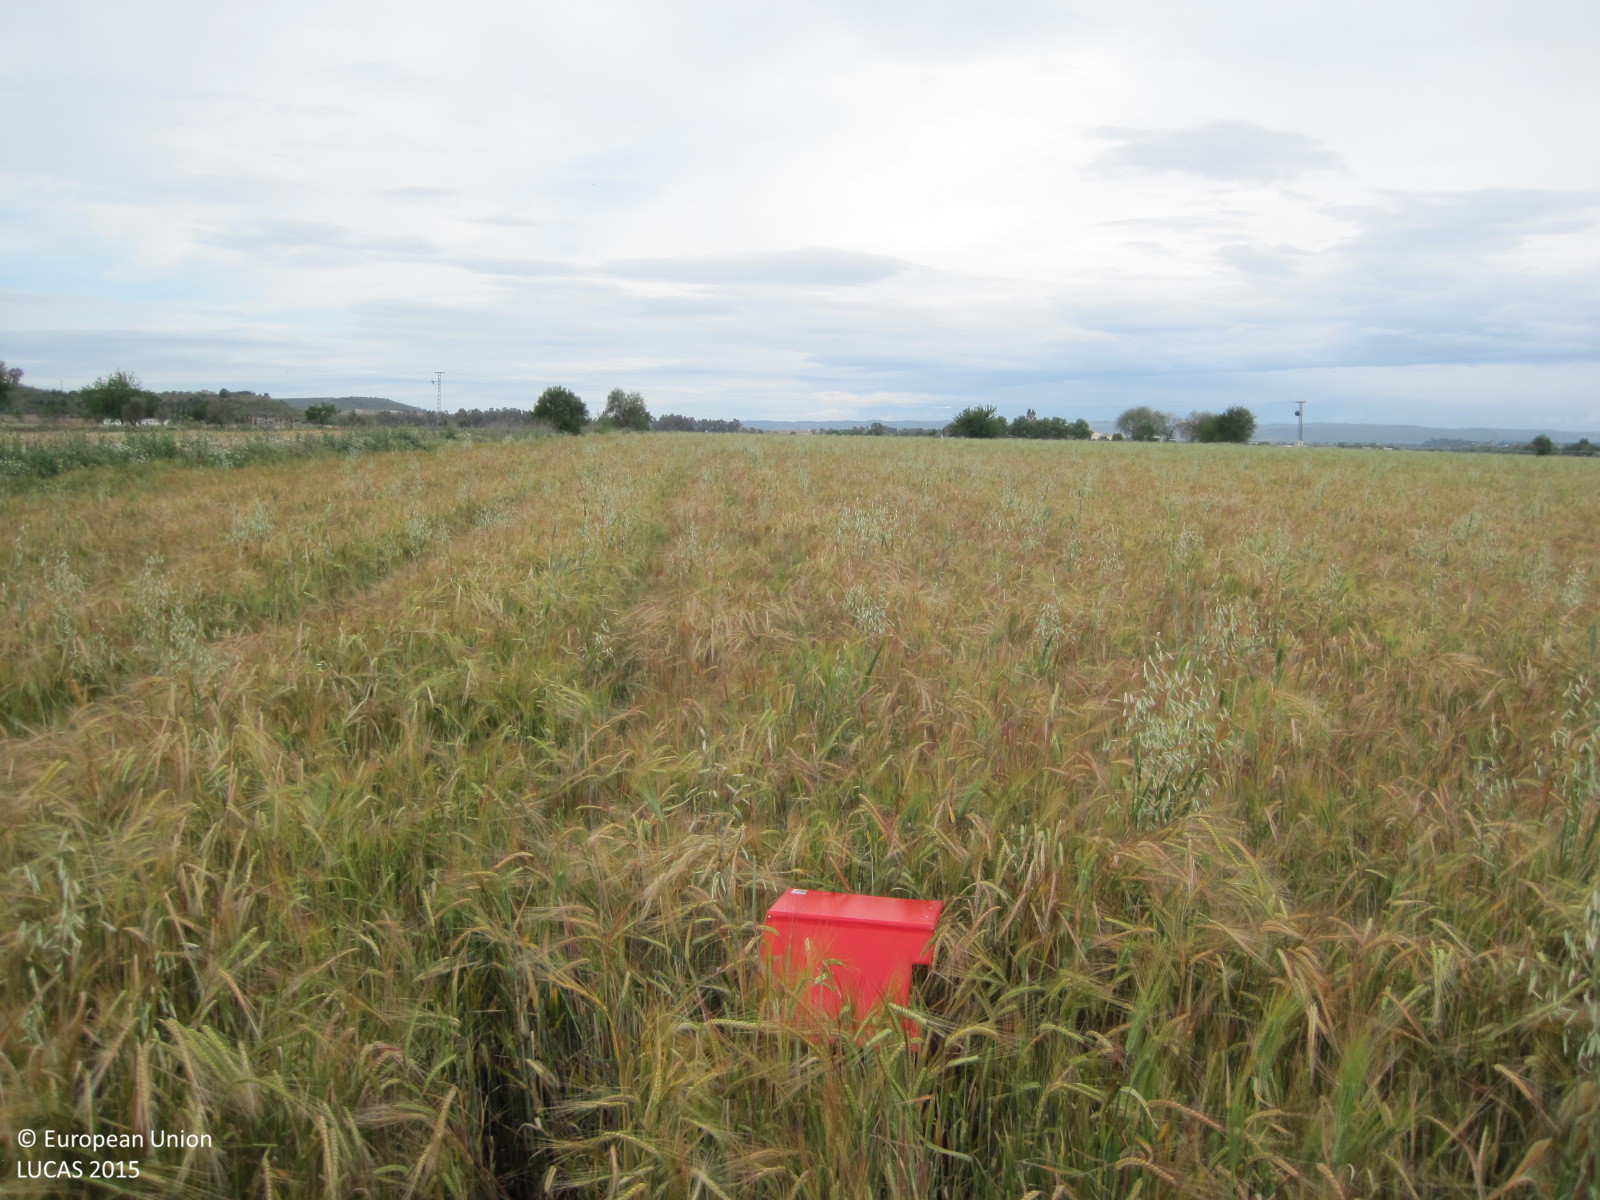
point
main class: Cropland
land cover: Mixed cereals for fodder
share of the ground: > 75 %
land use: Agriculture (excluding fallow land and kitchen gardens)
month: May
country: ES
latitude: 39.9481
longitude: -4.6638
